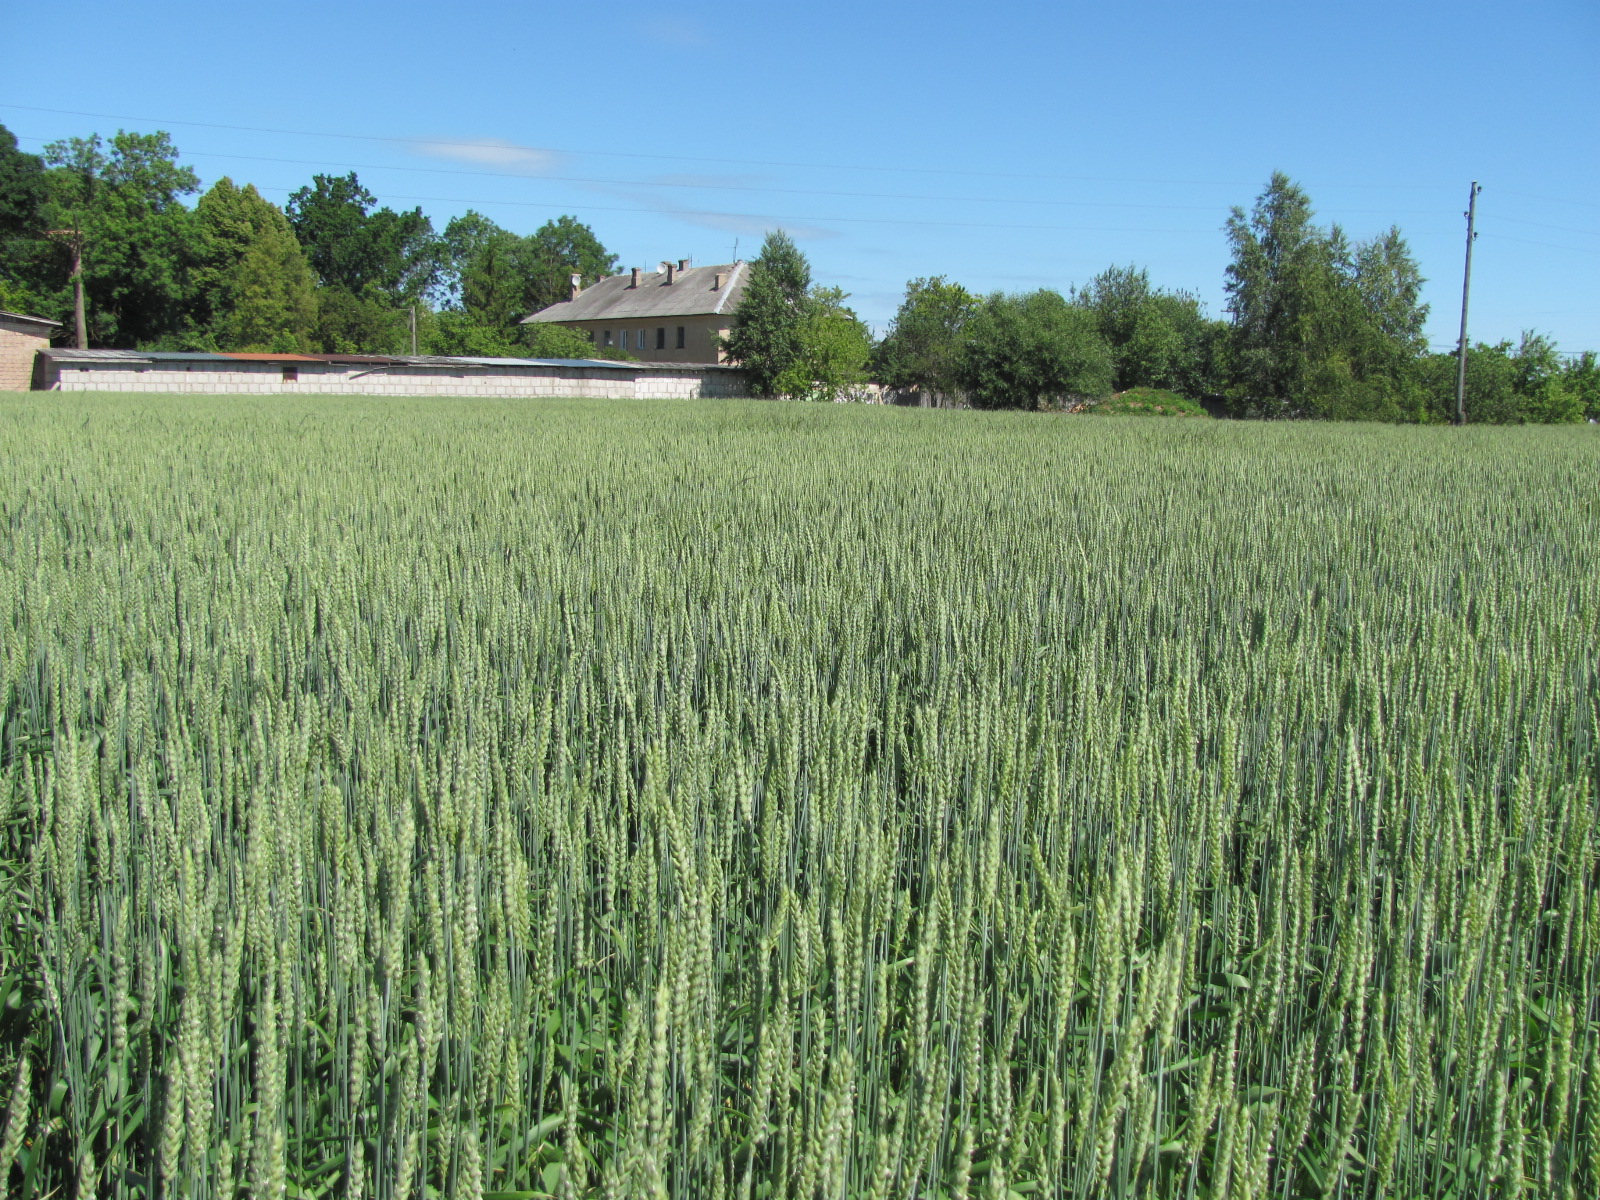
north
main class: Cropland
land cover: Common wheat
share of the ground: > 75 %
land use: Agriculture (excluding fallow land and kitchen gardens)
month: July
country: LV
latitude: 56.5419
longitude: 23.7242
